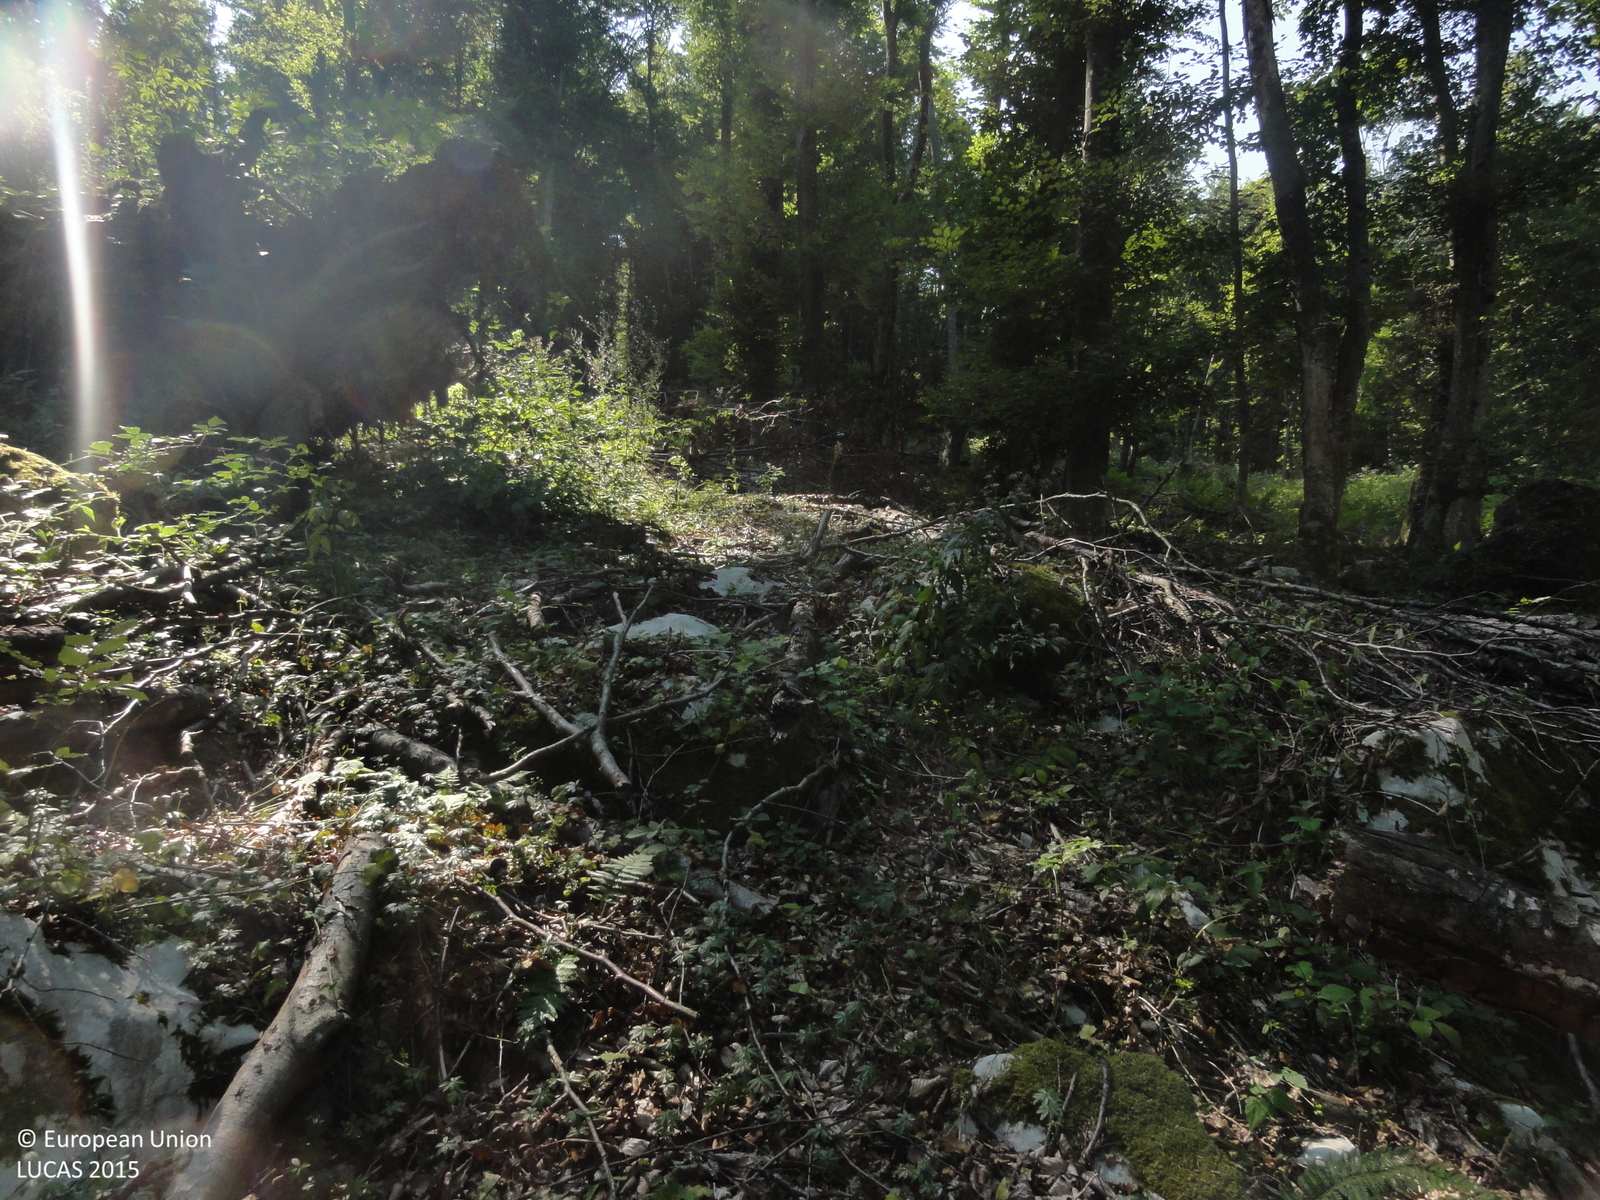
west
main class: Woodland
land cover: Broadleaved woodland
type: beech forest
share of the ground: > 75 %
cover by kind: broadleaved forest trees 80 %, herbaceous plants 15 %, consolidated bare surface 5 %
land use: Forestry
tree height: > 5 m
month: August
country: SI
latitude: 45.8538
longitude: 15.0320
